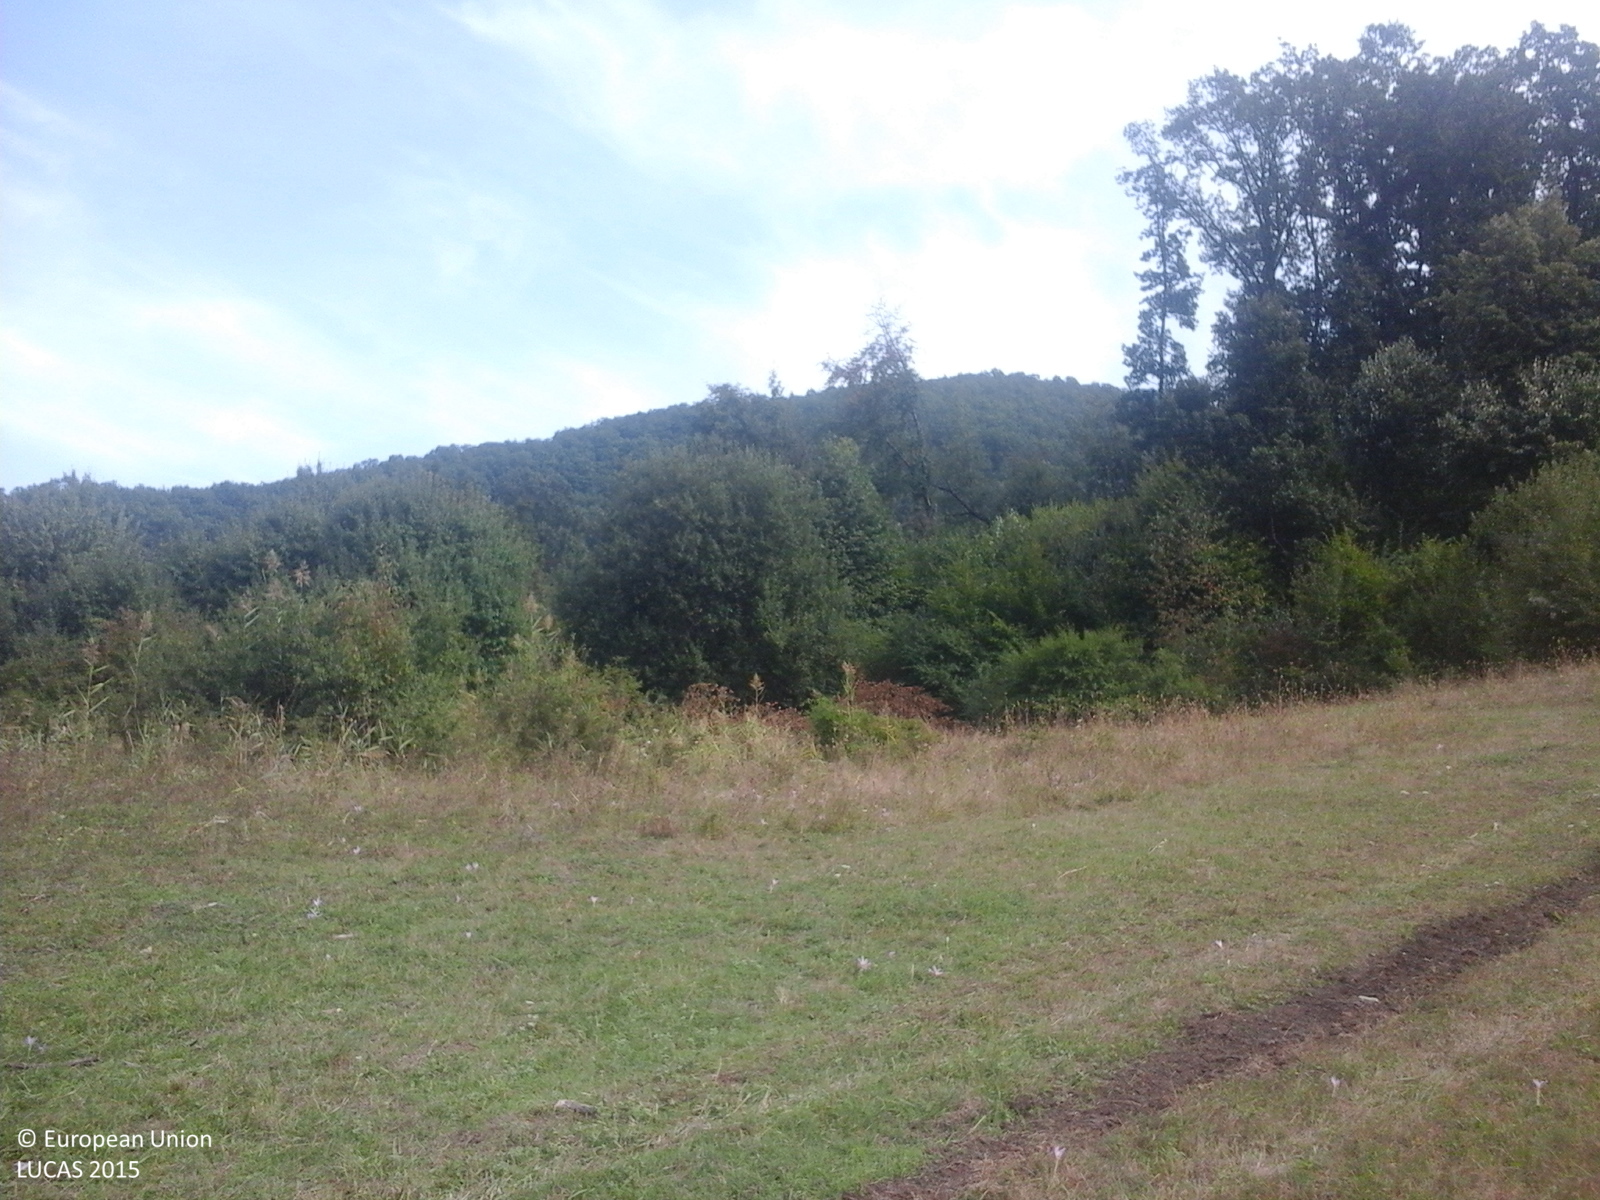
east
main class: Grassland
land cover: Spontaneously vegetated surfaces
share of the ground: > 75 %
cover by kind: herbaceous plants 100 %
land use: Fallow land
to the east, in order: Spontaneously vegetated surfaces; Tracks; Grassland with sparse tree/shrub cover; Broadleaved woodland; Grassland without tree/shrub cover; Single bushes/trees; Grassland without tree/shrub cover; Broadleaved woodland; Grassland without tree/shrub cover
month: September
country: RO
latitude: 47.0907
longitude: 23.2536
